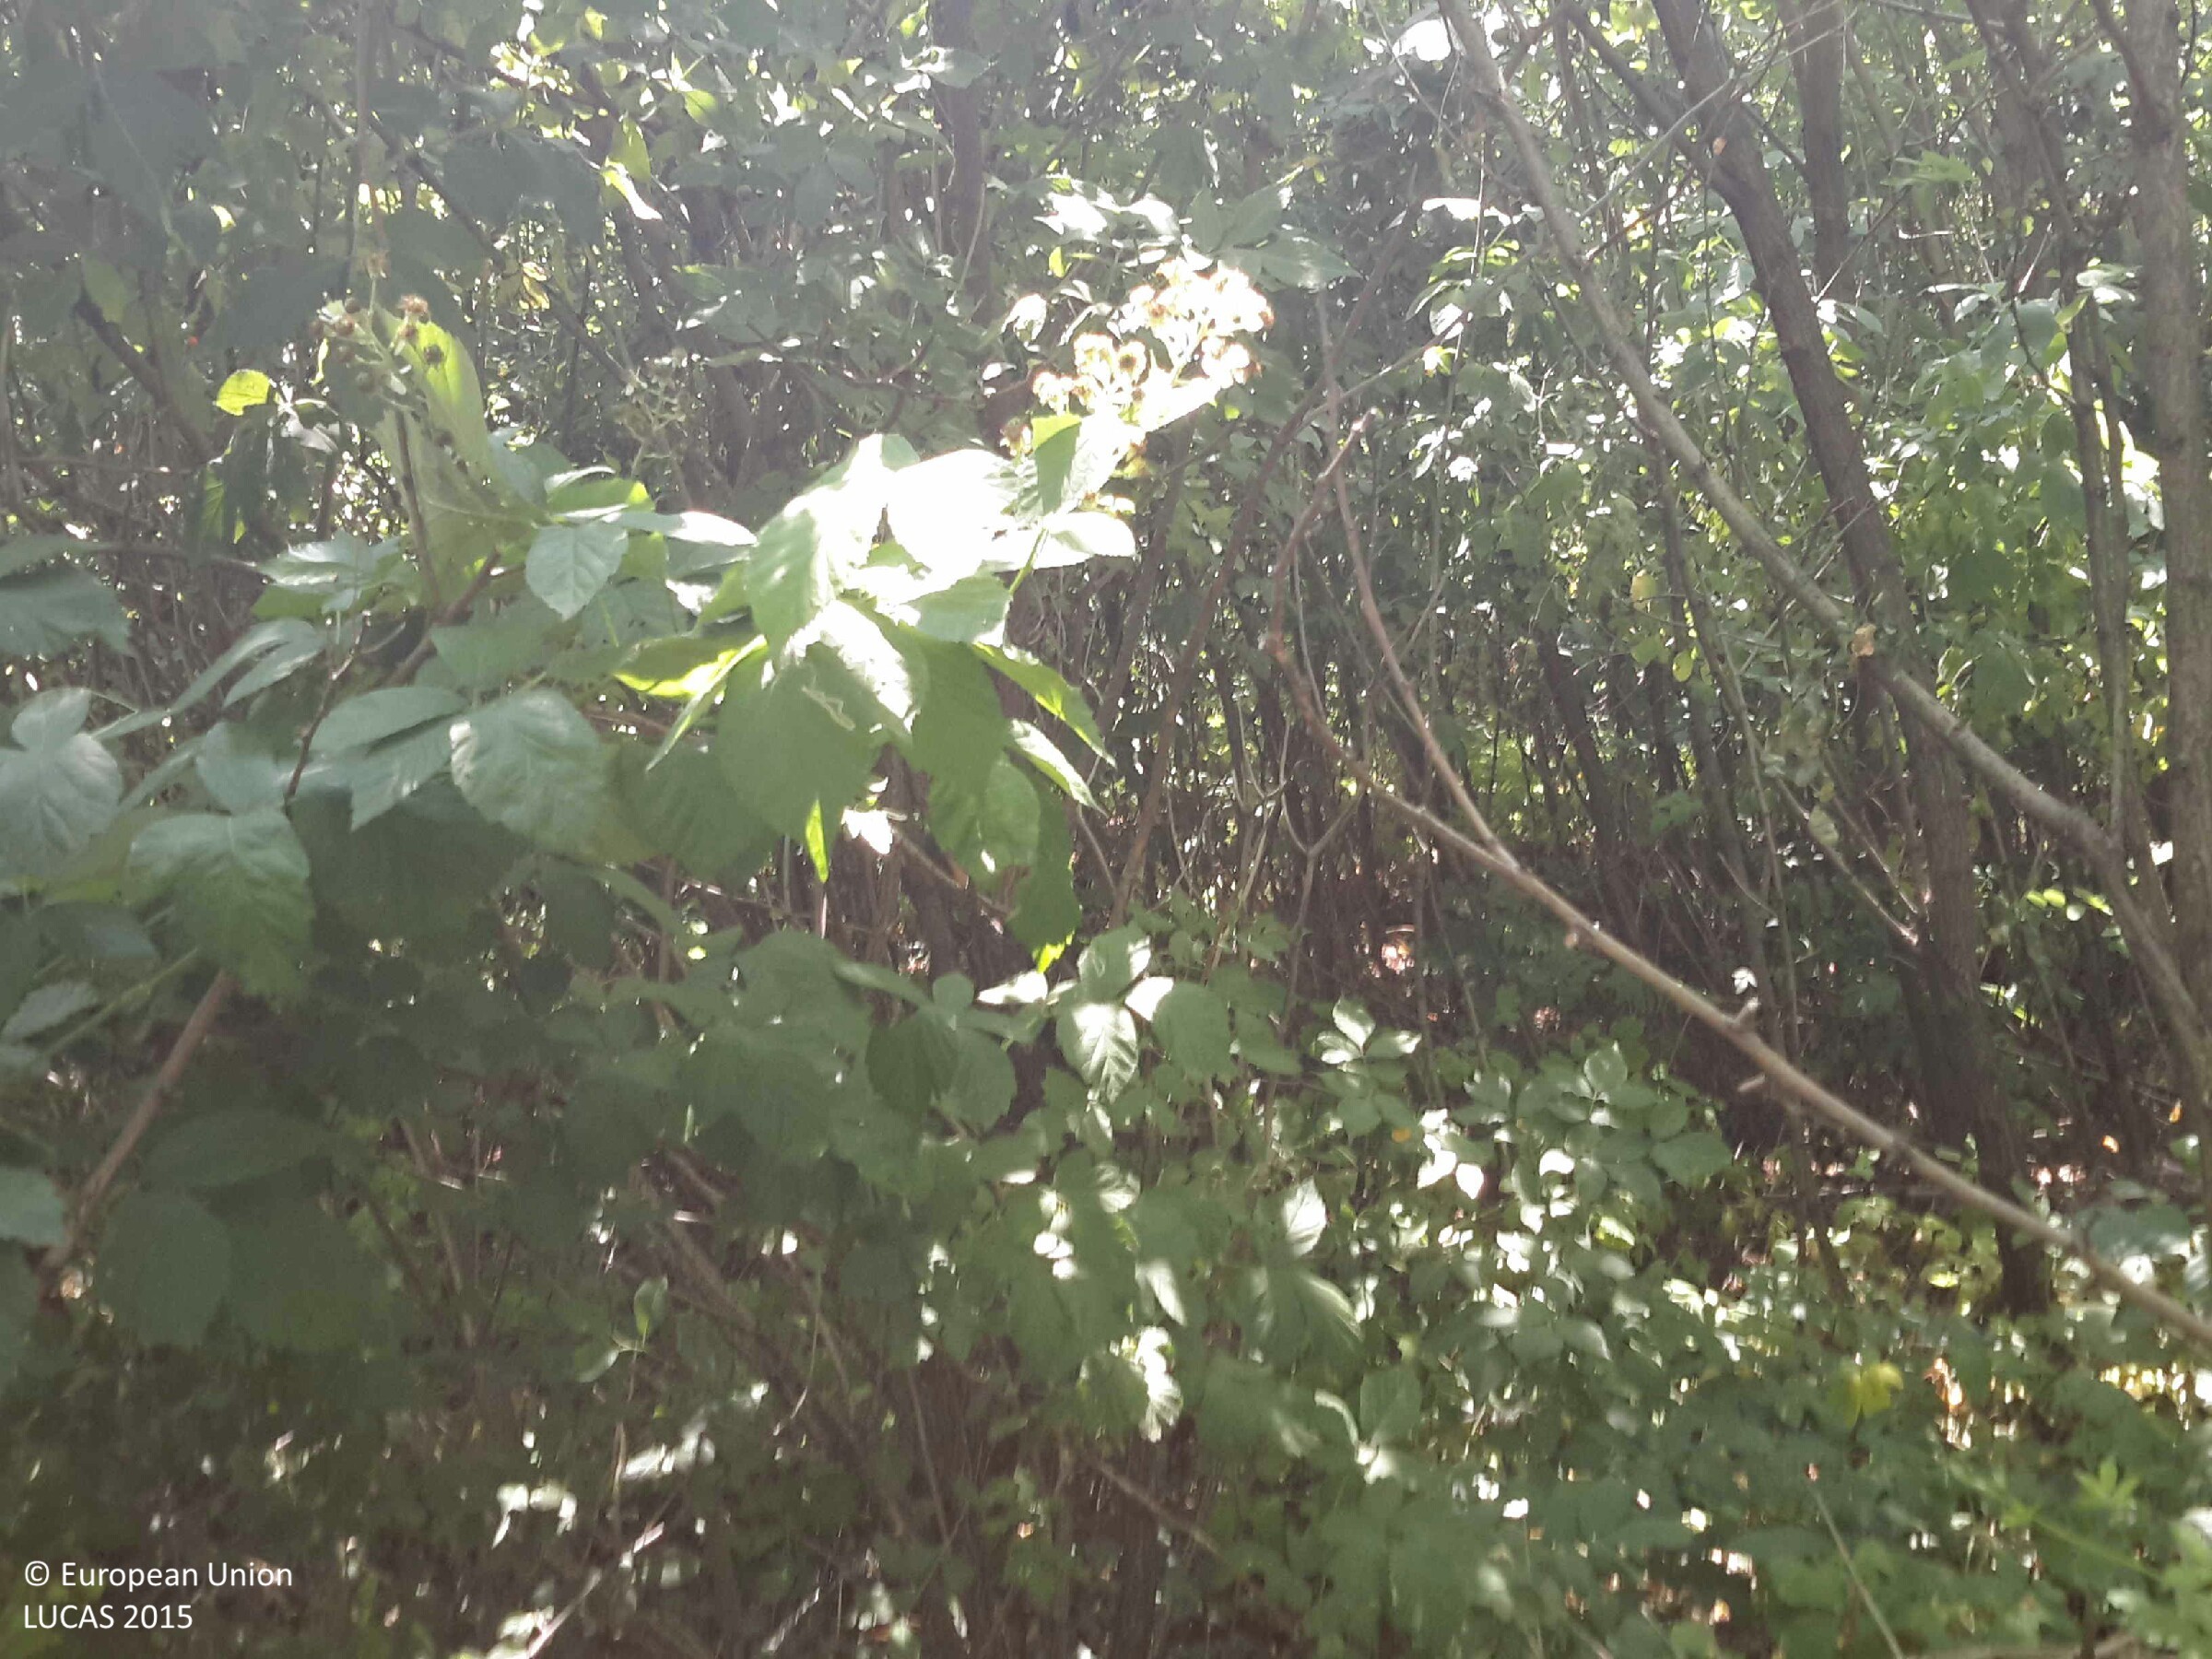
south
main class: Woodland
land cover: Broadleaved woodland
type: thermophilous deciduous forest
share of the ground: > 75 %
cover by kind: broadleaved forest trees 90 %, herbaceous plants 10 %
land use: Forestry
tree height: > 5 m
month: July
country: HU
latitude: 47.6225
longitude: 16.6978
